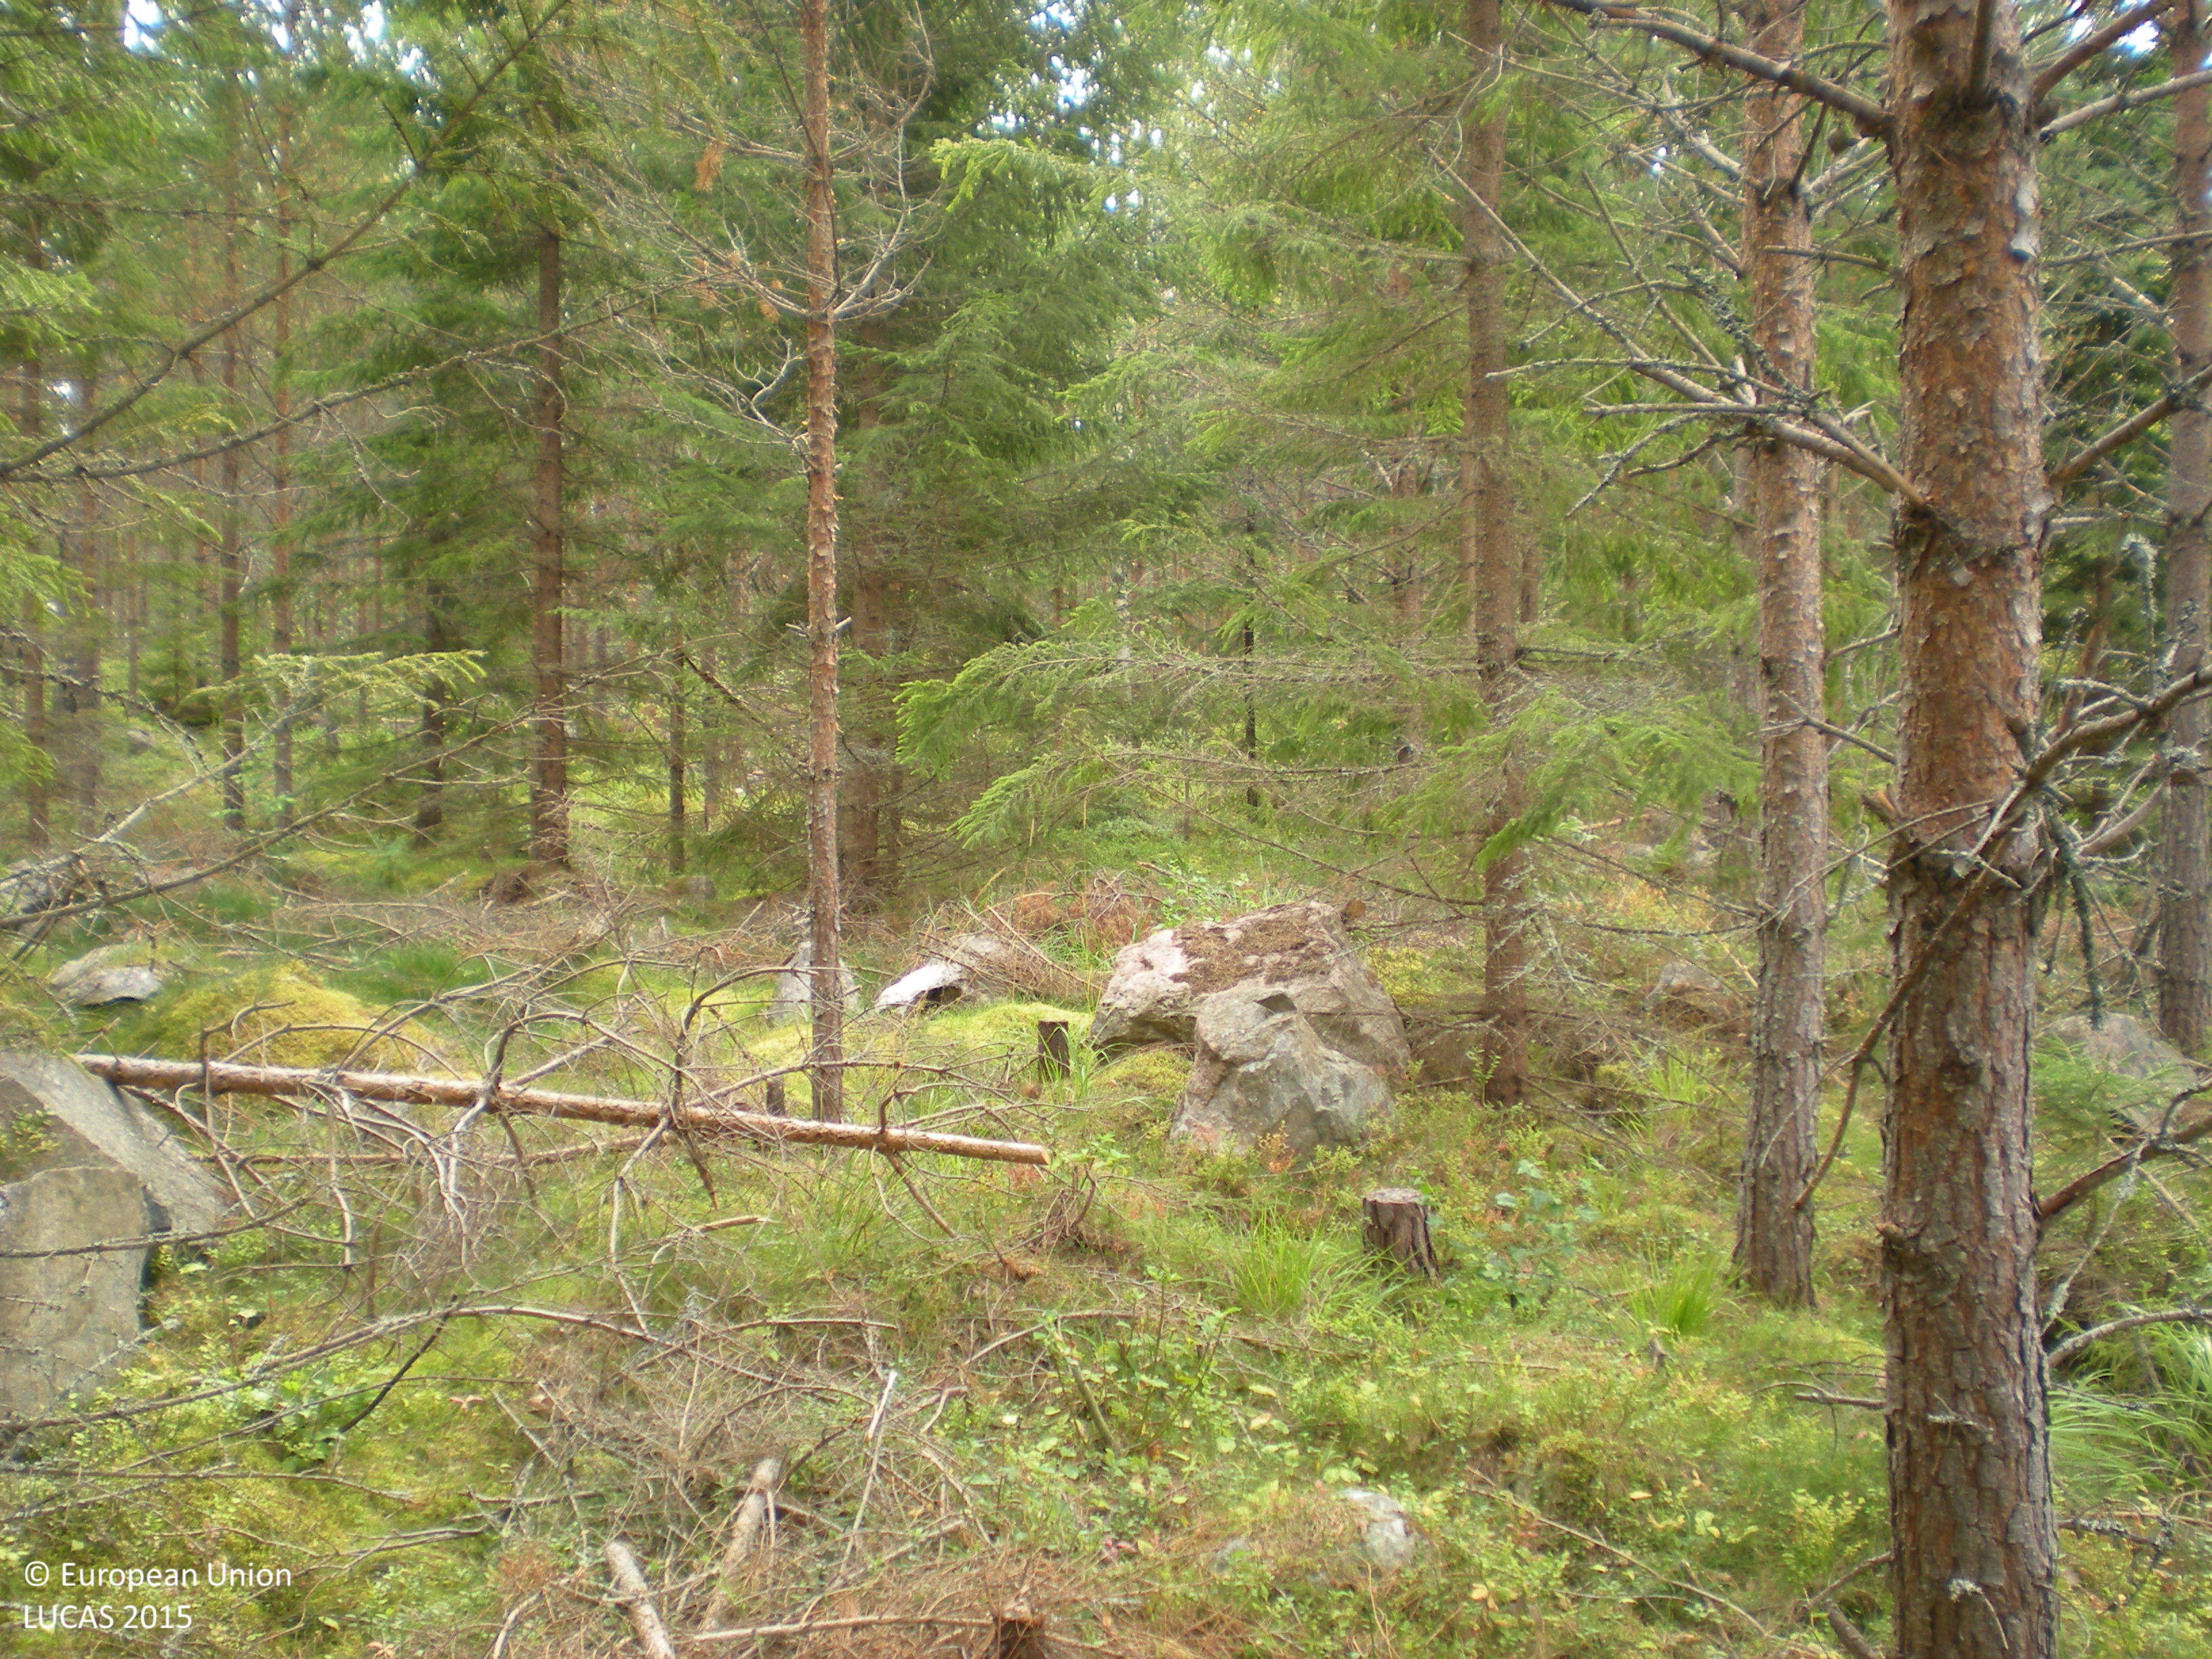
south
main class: Woodland
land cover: Other coniferous woodland
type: boreal forest
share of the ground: 50 - 75 %
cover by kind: coniferous forest trees 60 %, lichens and mosses 15 %, shrubs 10 %, broadleaved forest trees 5 %, herbaceous plants 5 %, consolidated bare surface 5 %
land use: Forestry
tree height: > 5 m
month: August
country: SE
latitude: 60.4419
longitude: 17.6790
